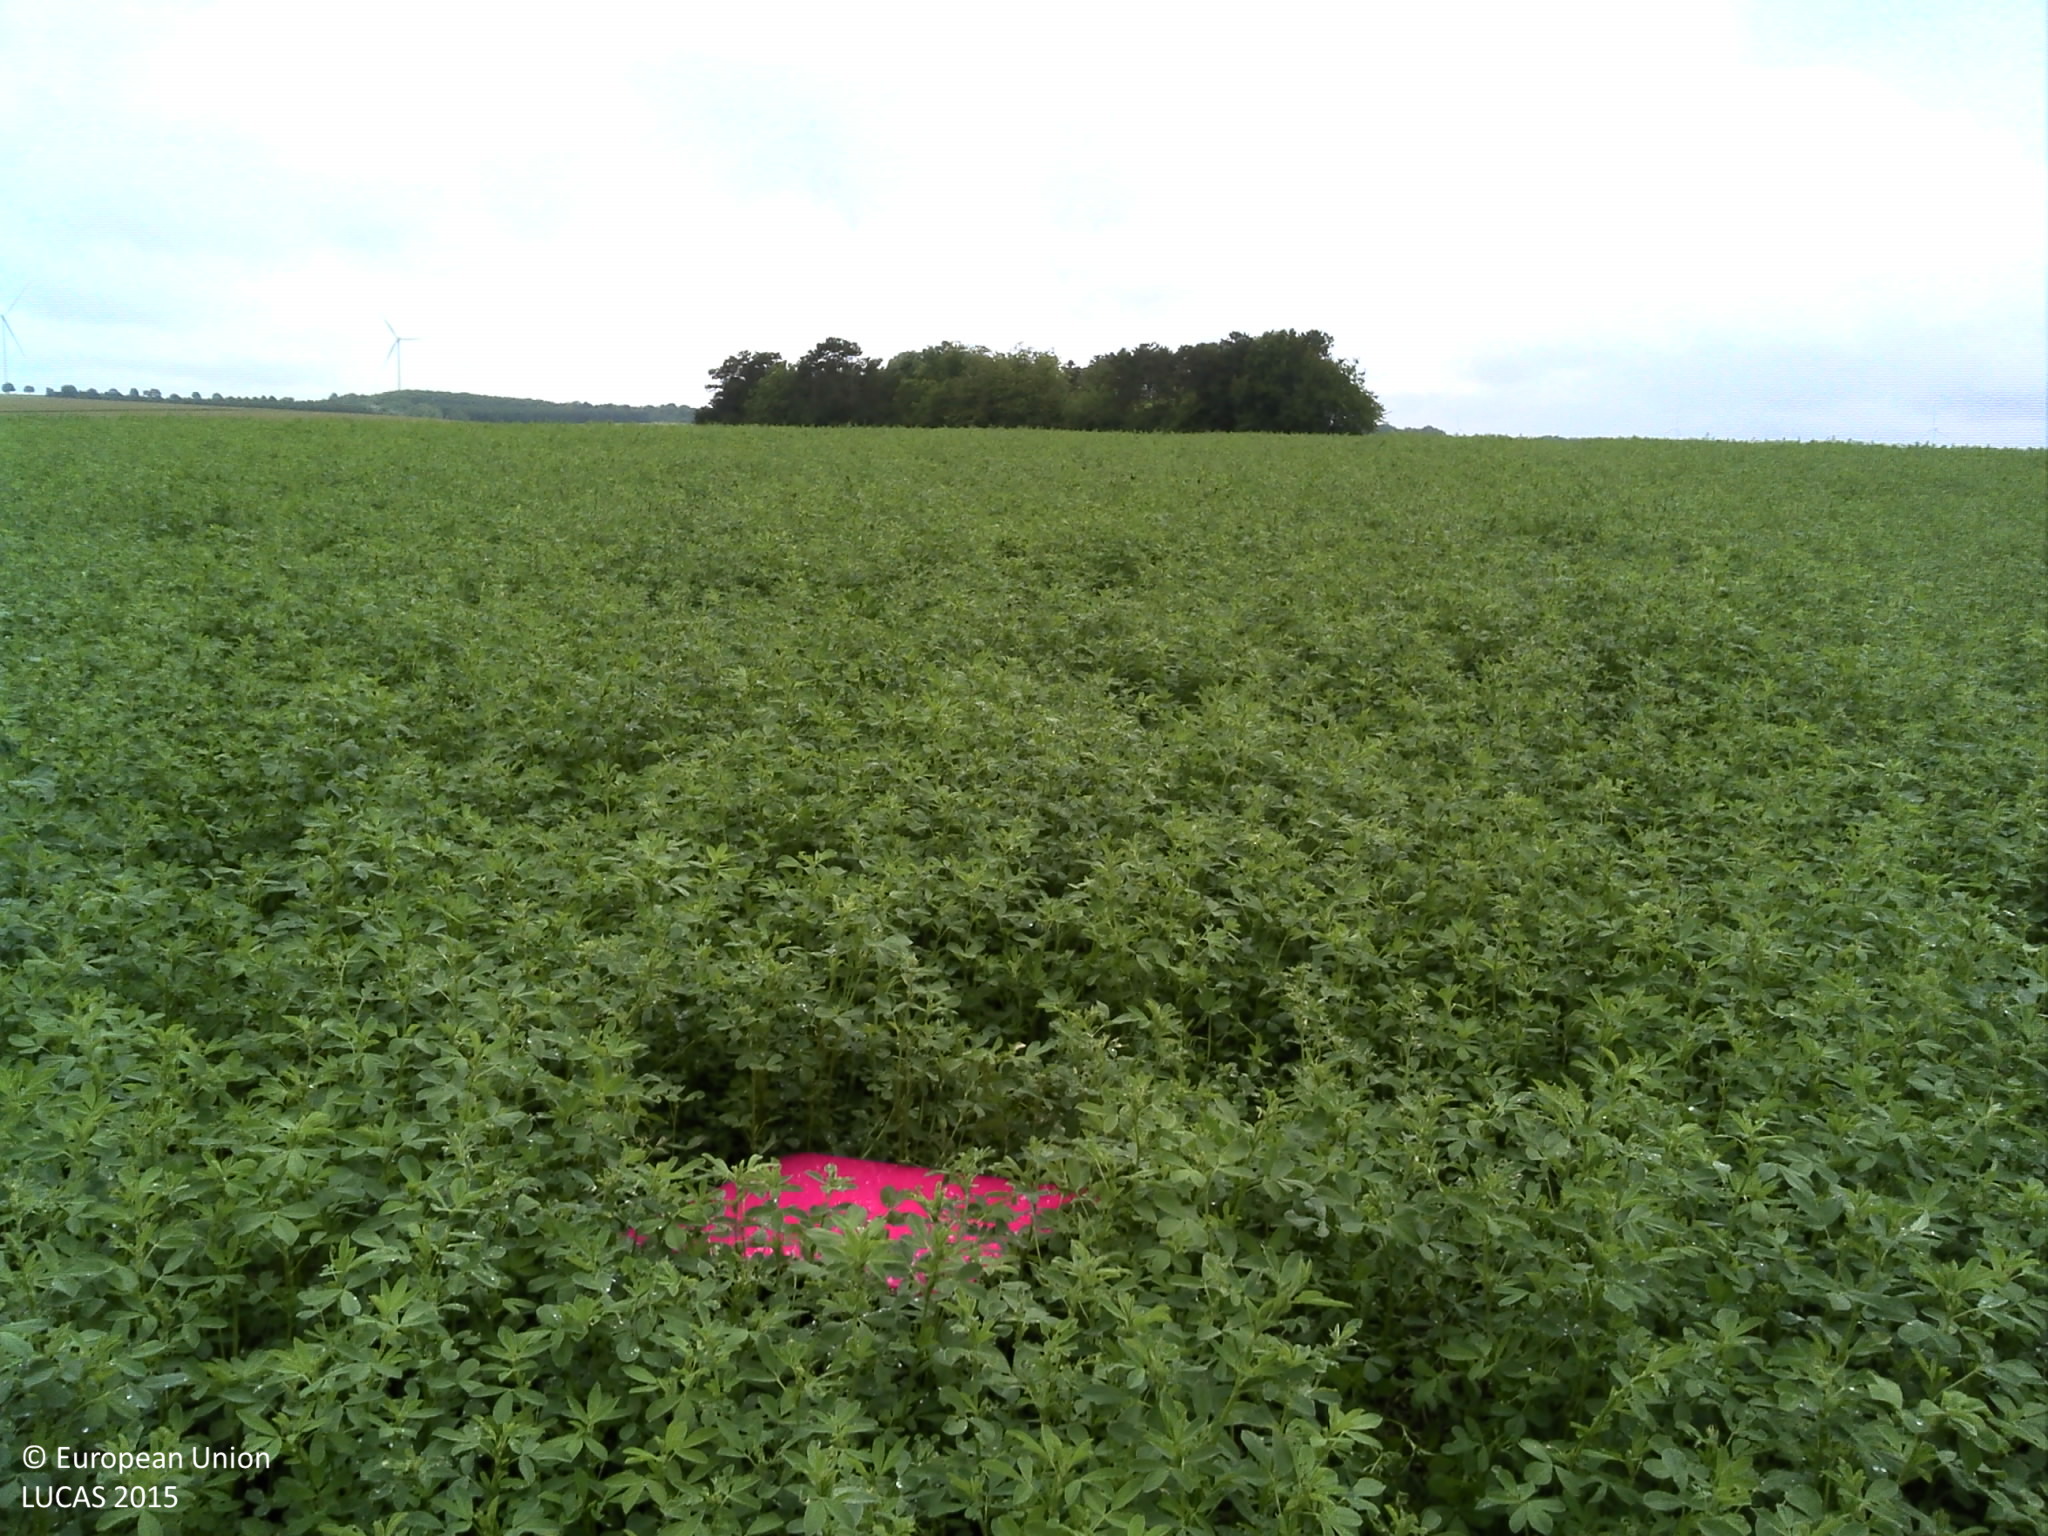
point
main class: Cropland
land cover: Lucerne
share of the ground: > 75 %
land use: Agriculture (excluding fallow land and kitchen gardens)
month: June
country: FR
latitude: 48.6302
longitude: 4.2025
